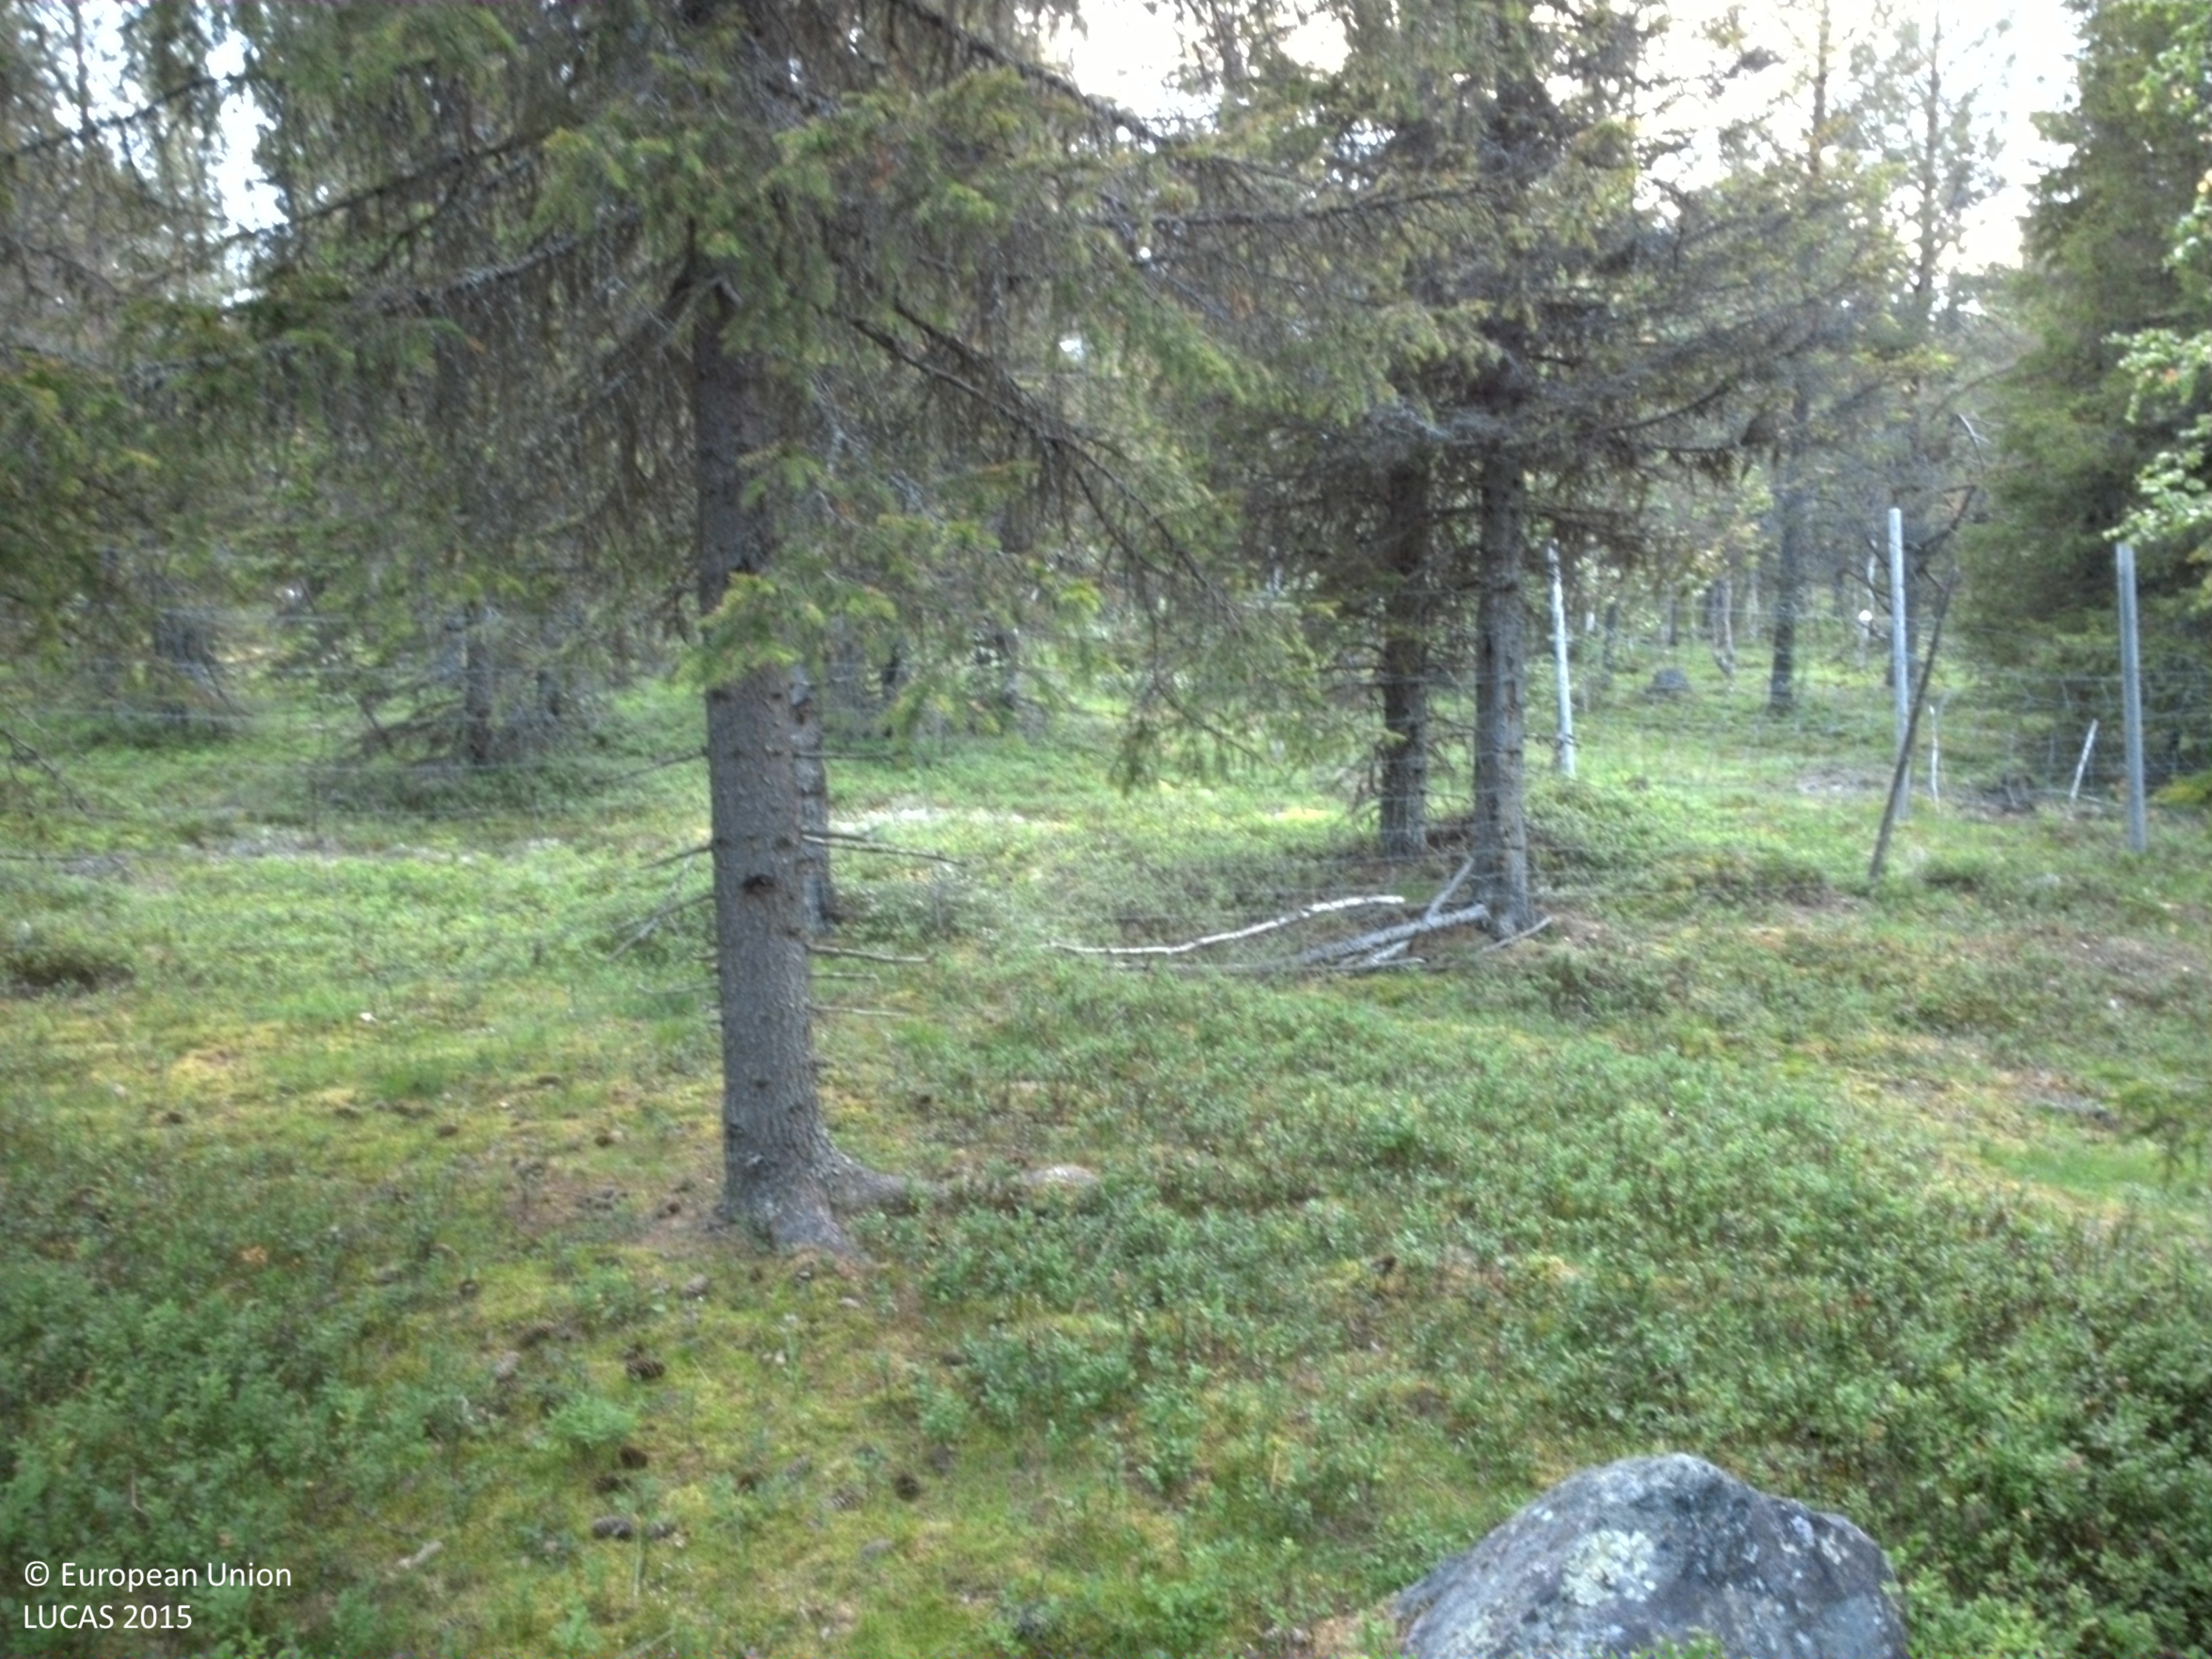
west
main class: Woodland
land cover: Pine dominated coniferous woodland
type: boreal forest
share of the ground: 25 - 50 %
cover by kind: shrubs 55 %, coniferous forest trees 30 %, broadleaved forest trees 5 %, herbaceous plants 5 %, lichens and mosses 5 %
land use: Forestry
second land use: Other primary production
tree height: > 5 m
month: August
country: SE
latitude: 66.6553
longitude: 20.6065
